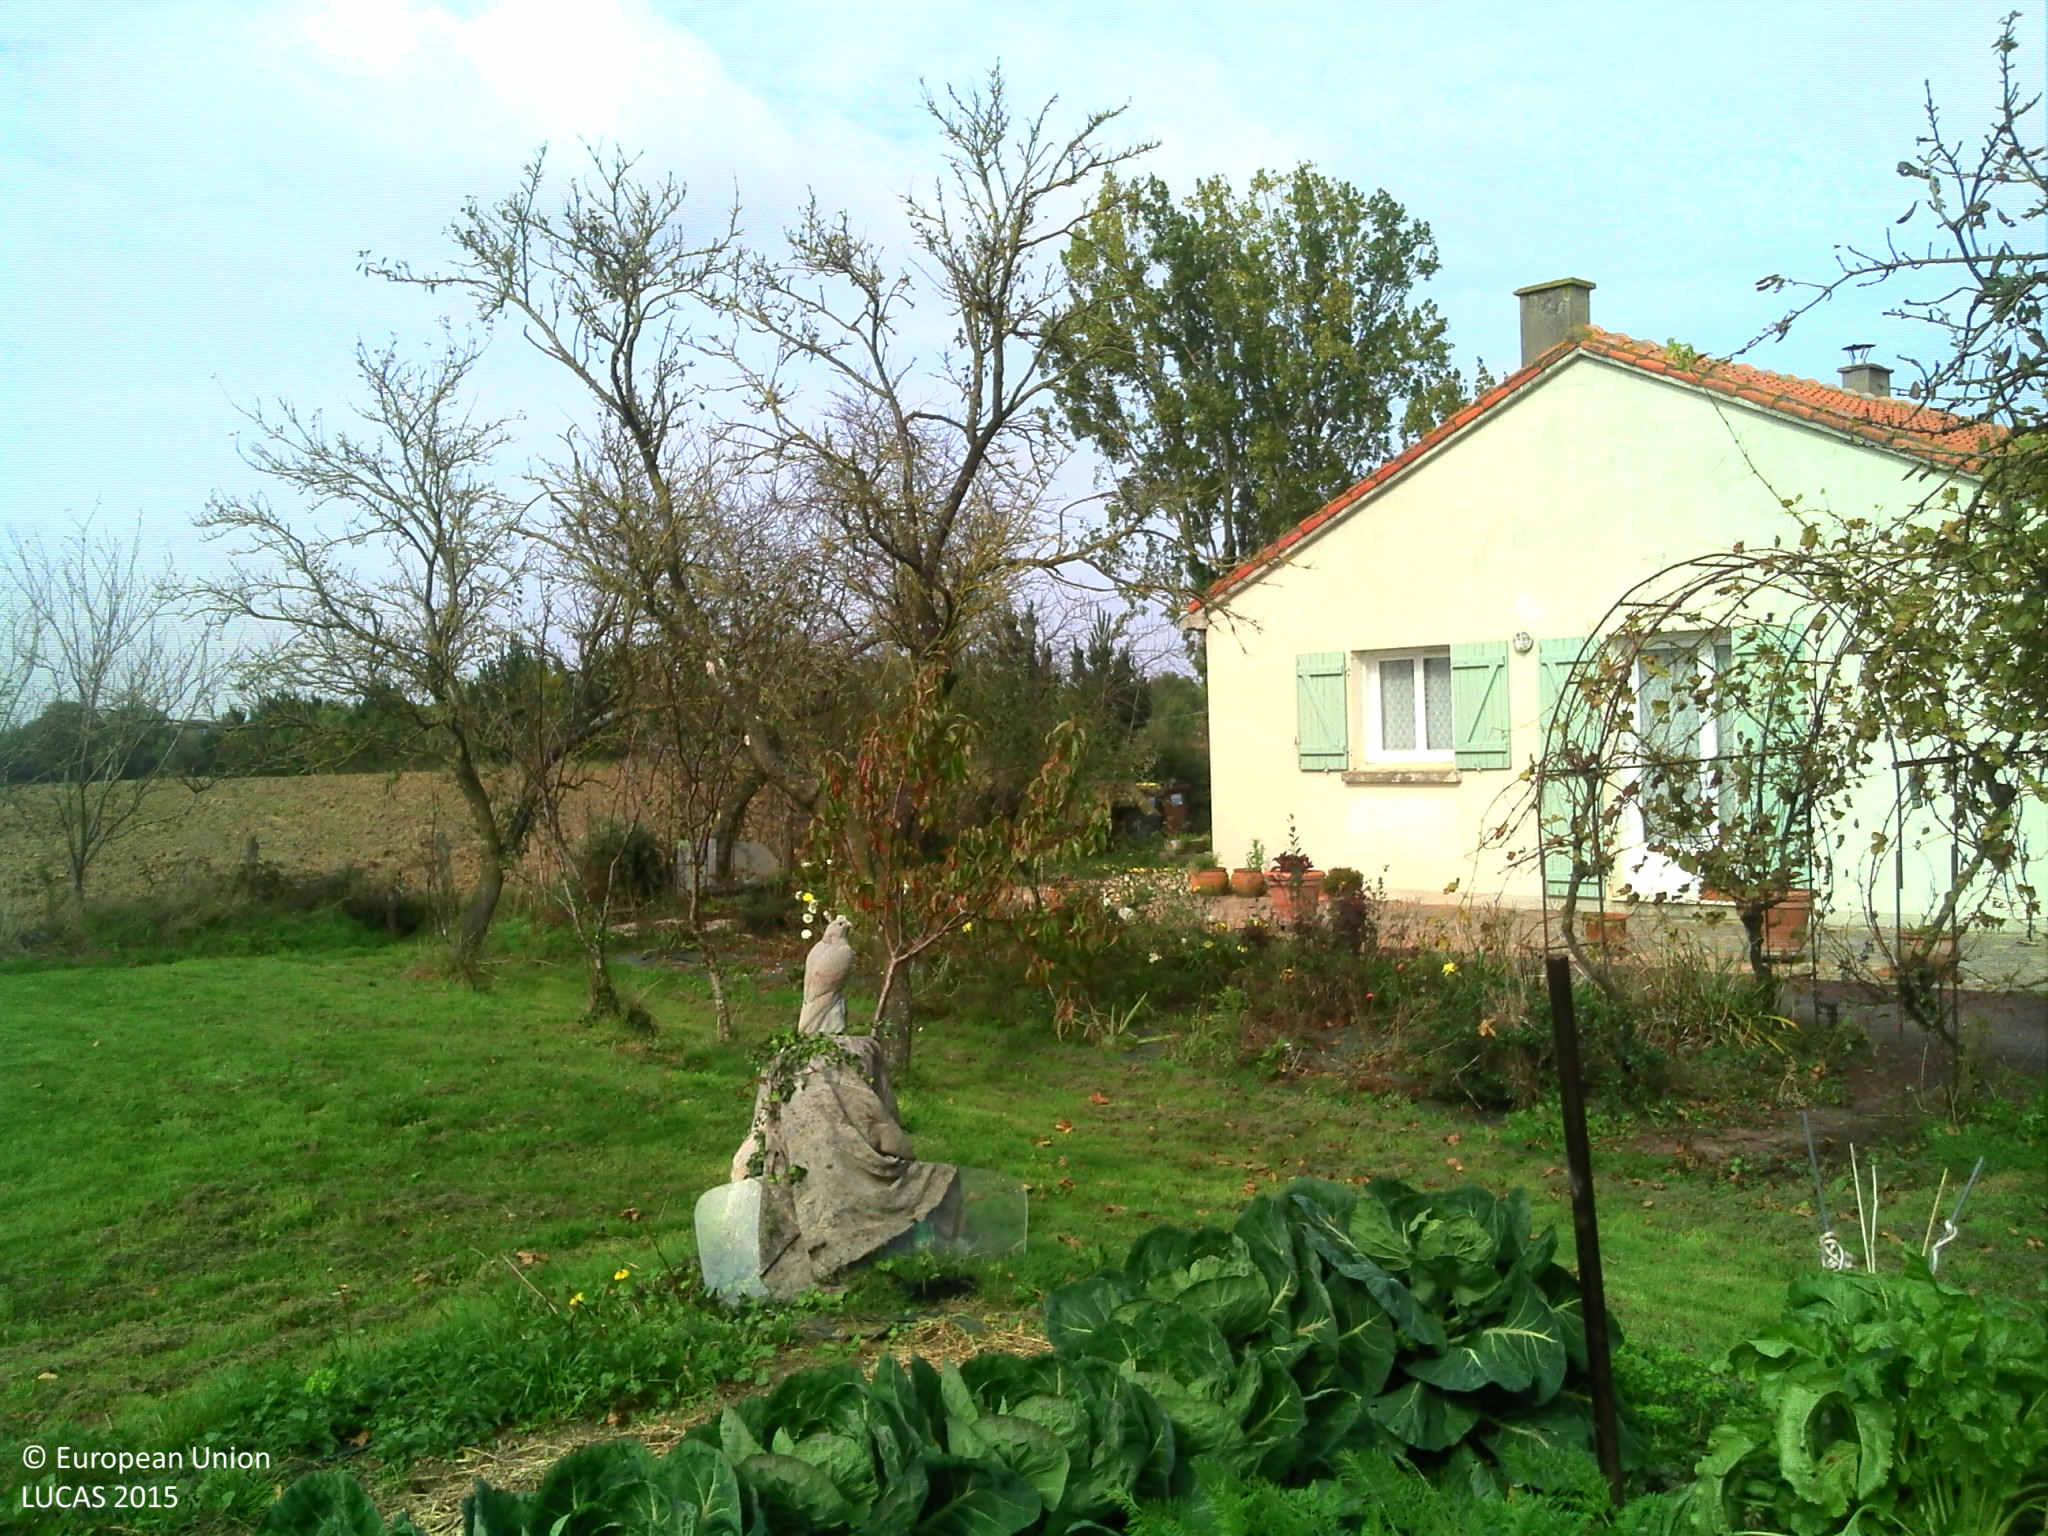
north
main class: Cropland
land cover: Other root crops
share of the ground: > 75 %
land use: Kitchen garden
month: October
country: FR
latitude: 47.1124
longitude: -0.9596
